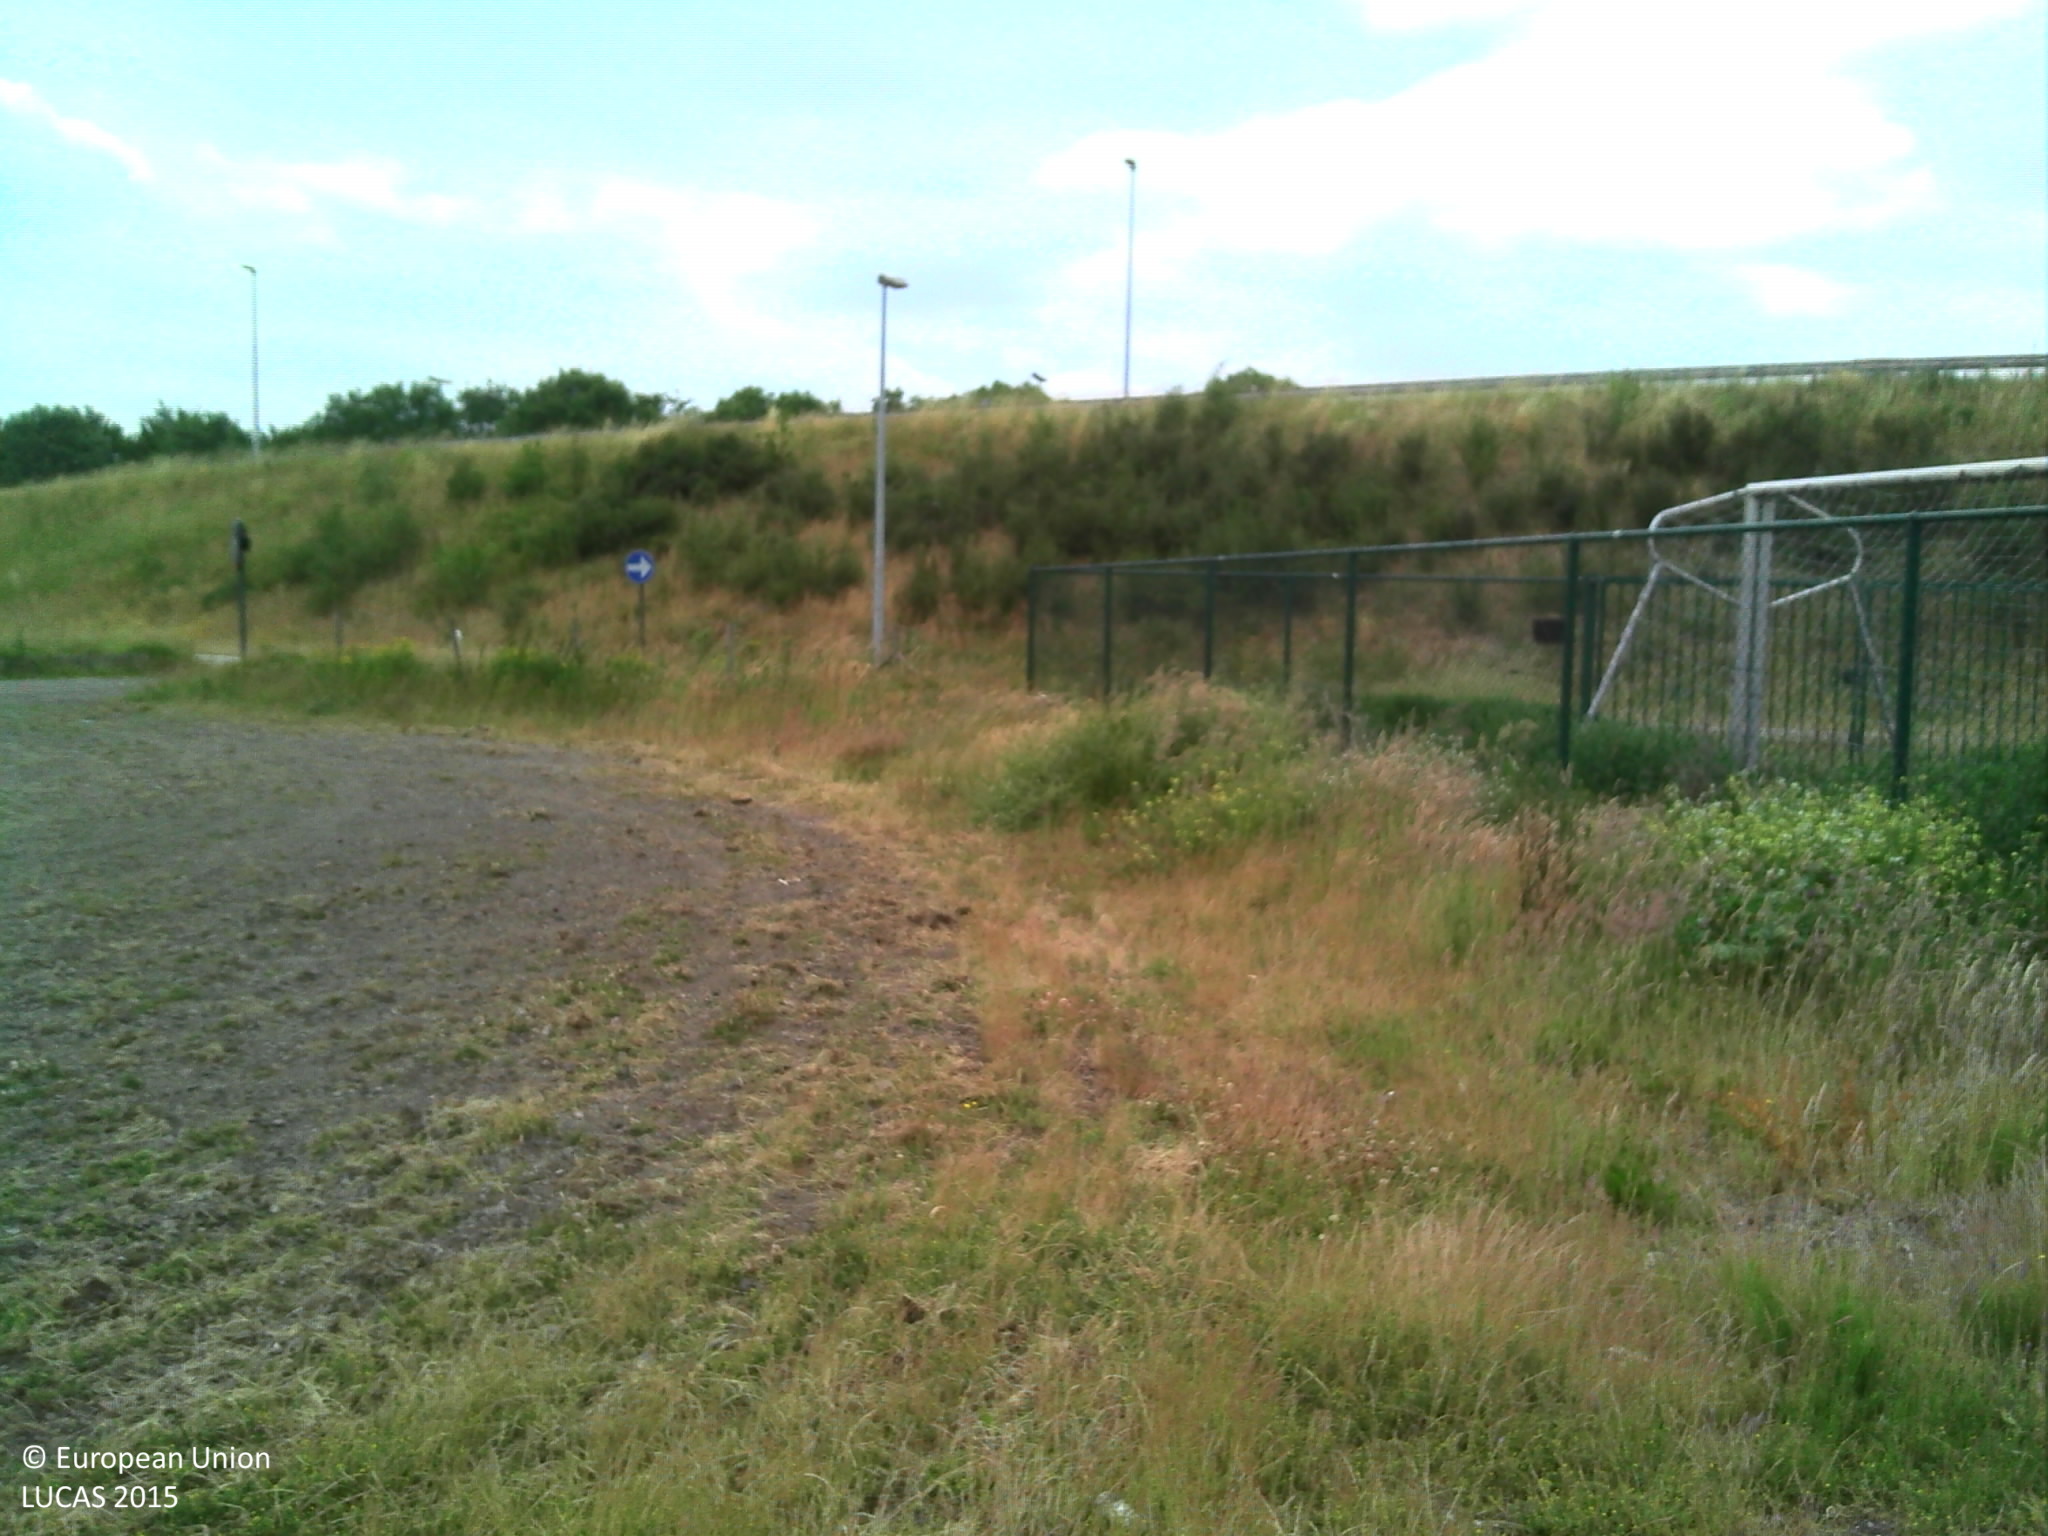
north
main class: Grassland
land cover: Grassland without tree/shrub cover
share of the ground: > 75 %
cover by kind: herbaceous plants 100 %
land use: Sport
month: June
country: BE
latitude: 51.2175
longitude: 4.0241
